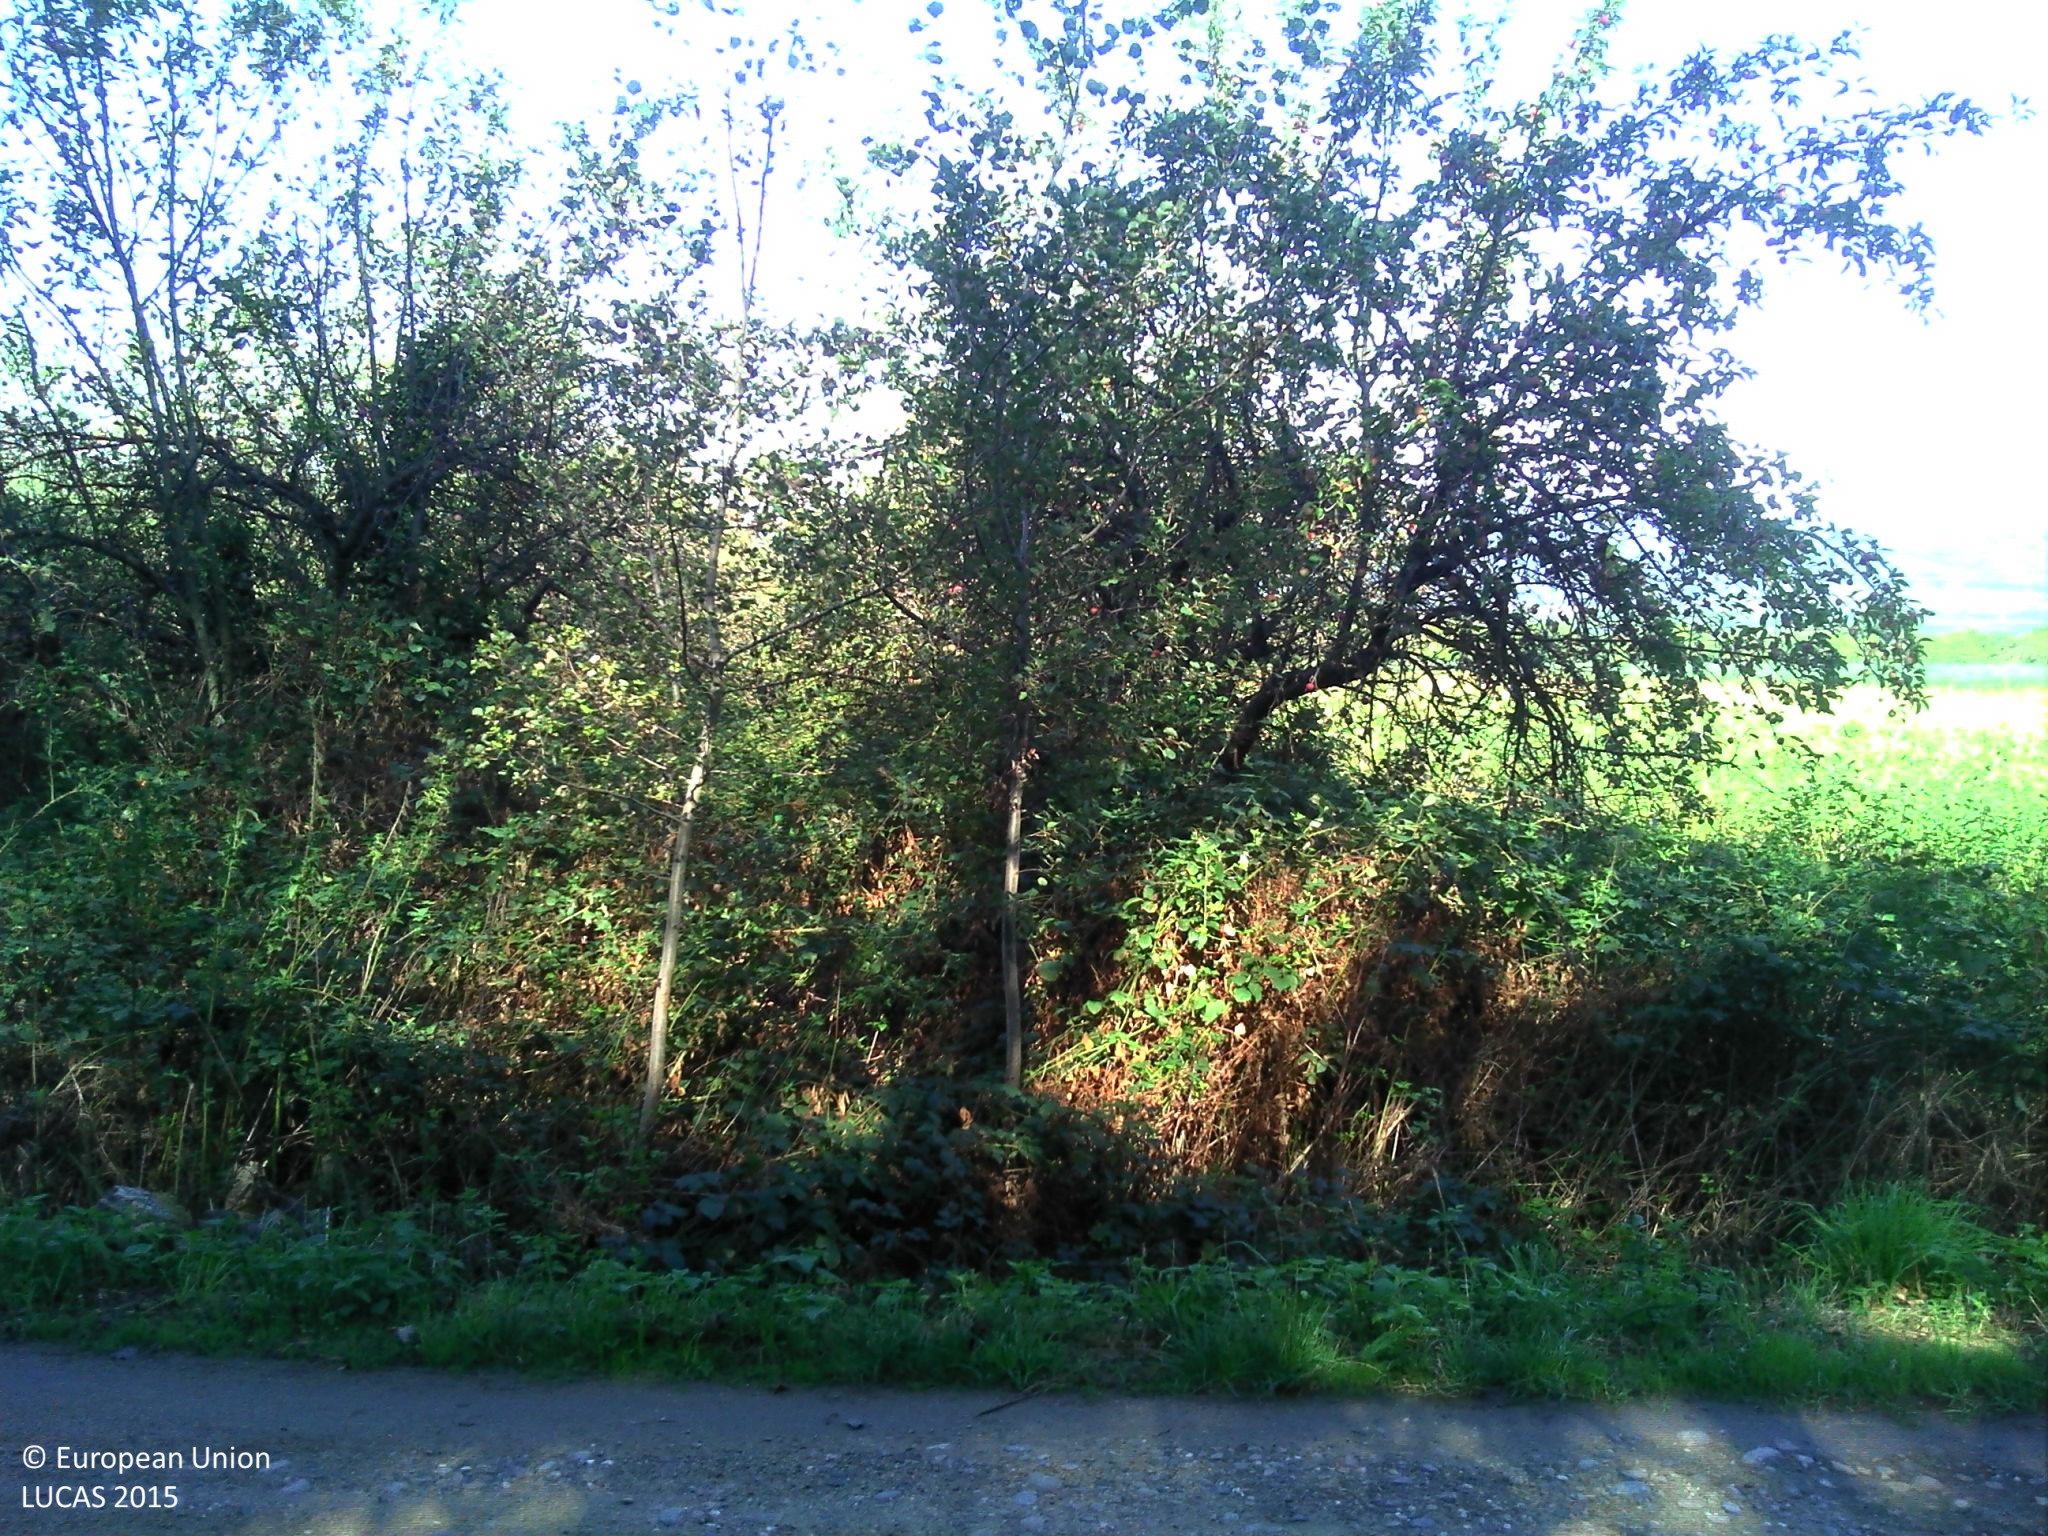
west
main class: Woodland
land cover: Broadleaved woodland
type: mesophytic deciduous forest
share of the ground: > 75 %
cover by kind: broadleaved forest trees 100 %
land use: Semi-natural and natural areas not in use
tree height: > 5 m
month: August
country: FR
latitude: 48.1378
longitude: 7.3538
